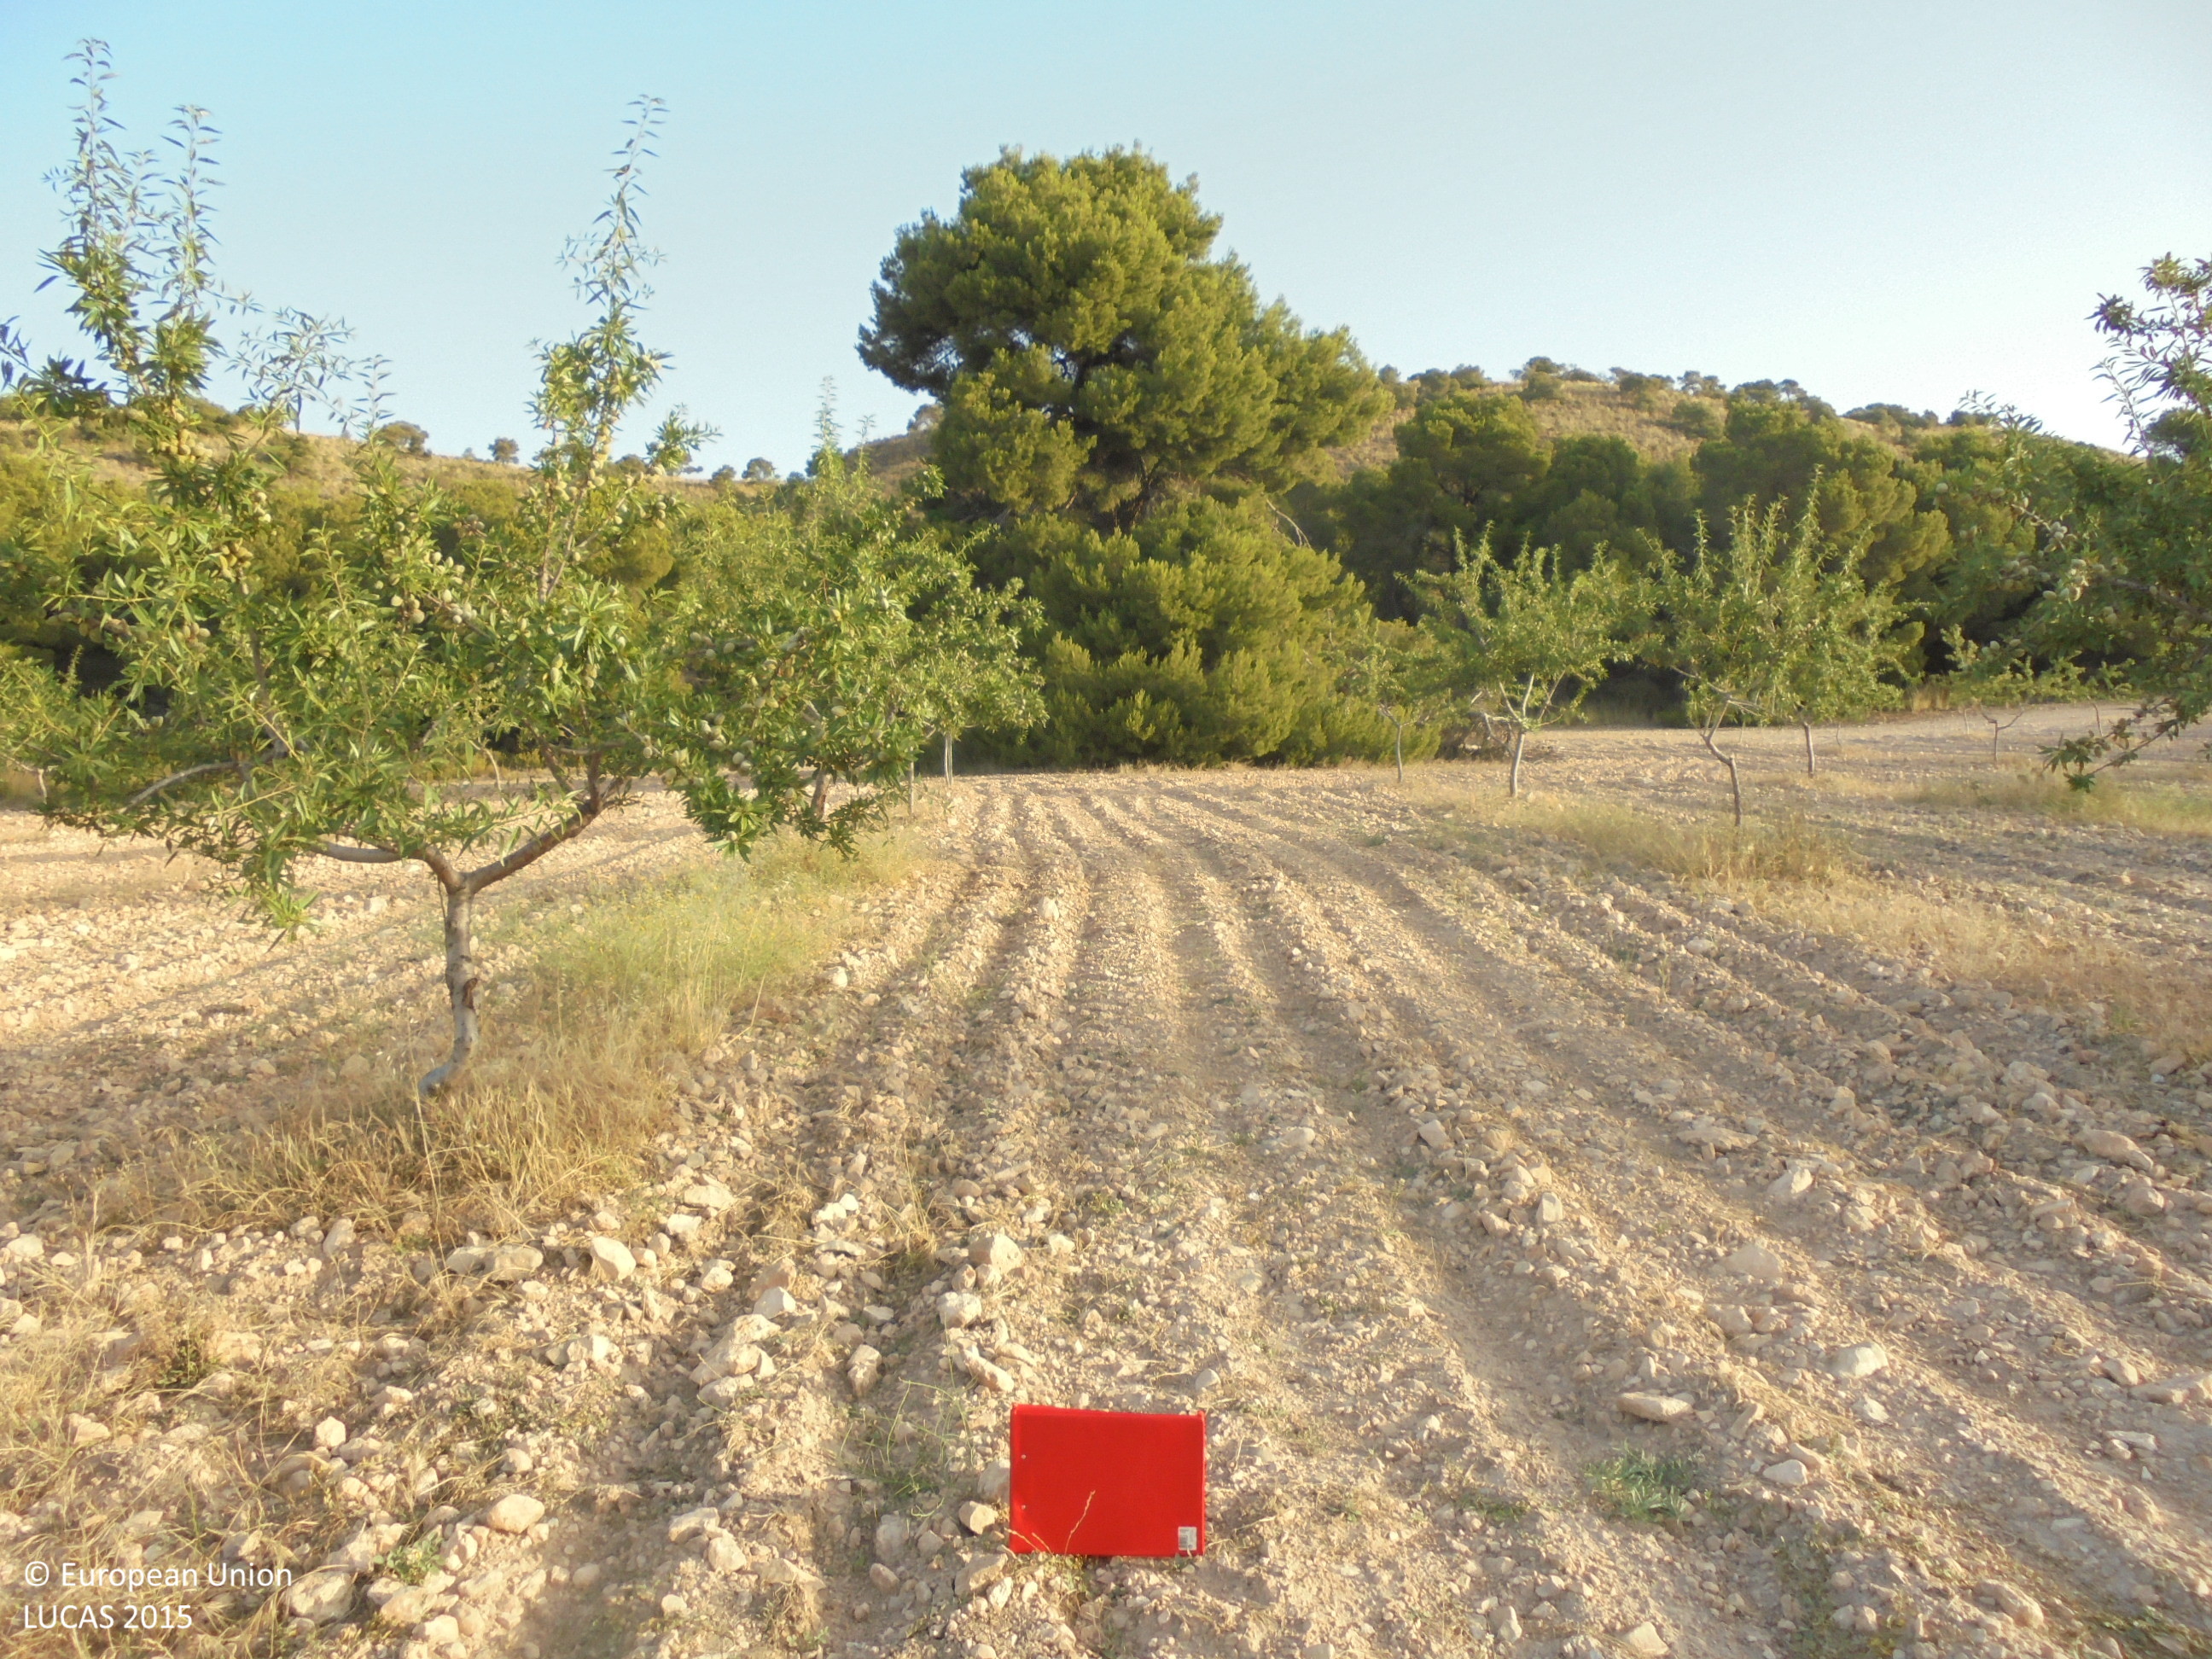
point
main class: Cropland
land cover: Nuts trees
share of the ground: 10 - 25 %
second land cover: Spontaneously vegetated surfaces
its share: 25 - 50 %
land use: Agriculture (excluding fallow land and kitchen gardens)
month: July
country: ES
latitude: 38.7221
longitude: -1.7165
